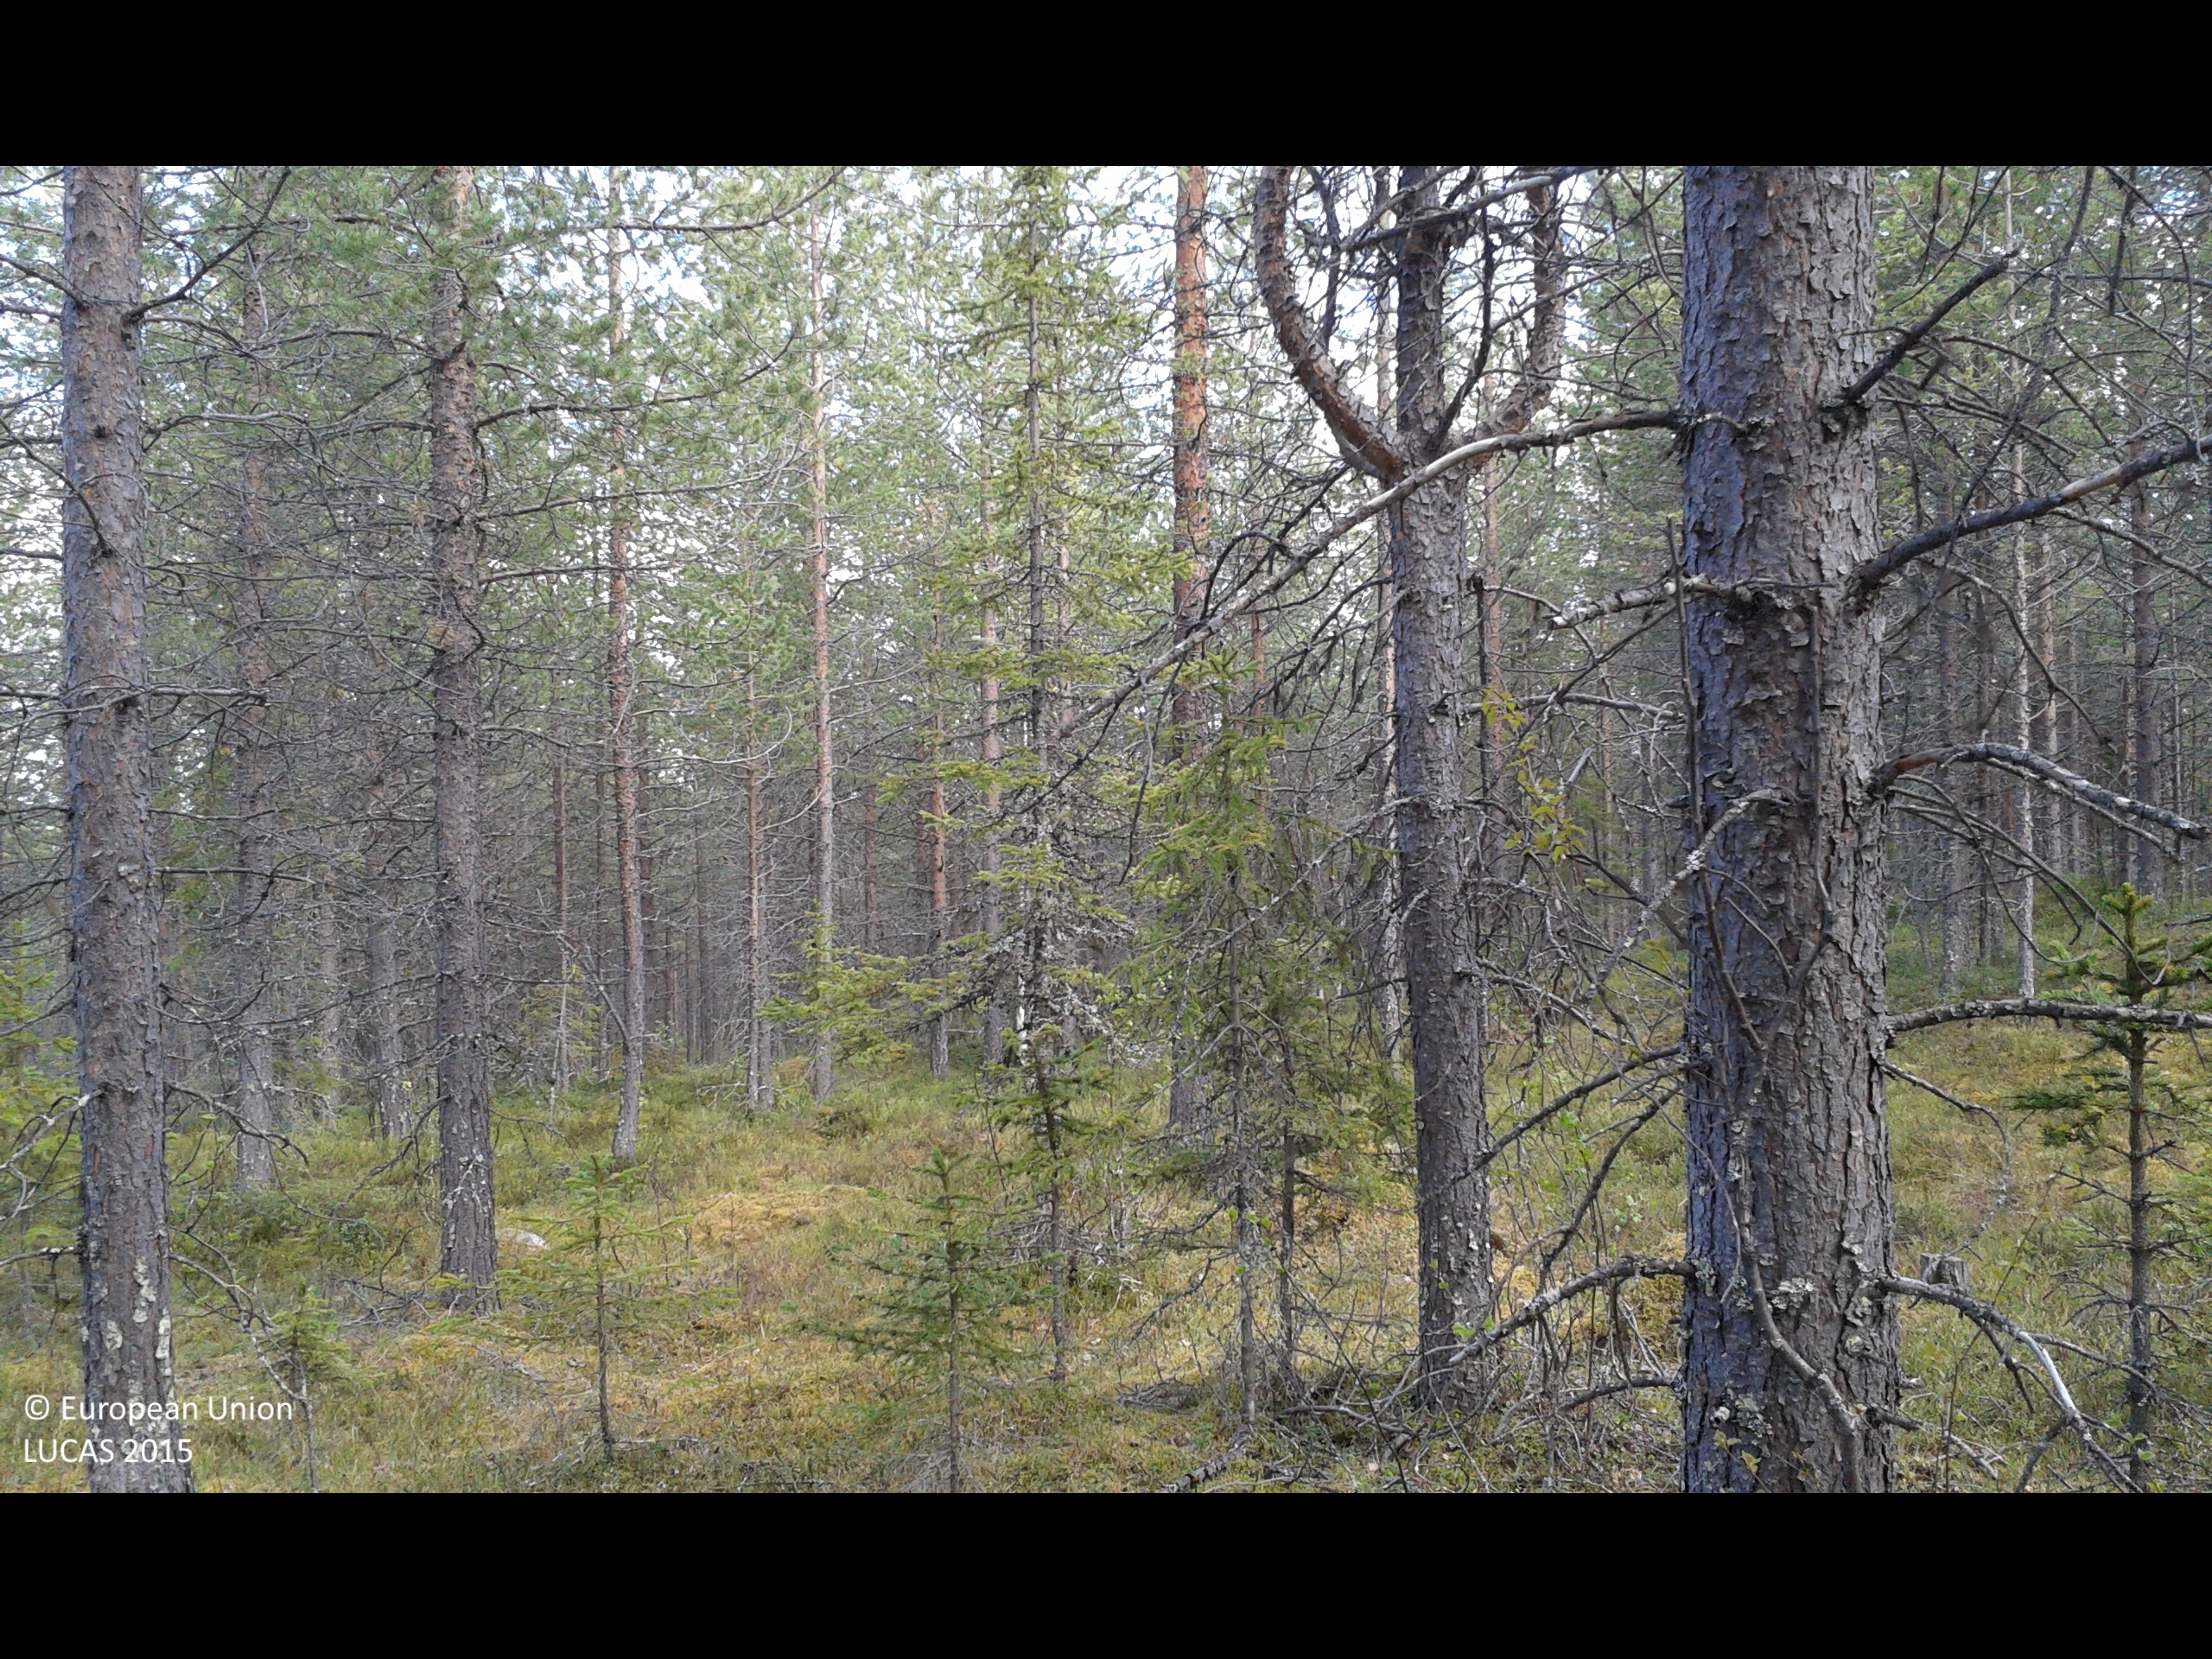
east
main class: Woodland
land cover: Pine dominated coniferous woodland
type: boreal forest
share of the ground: 25 - 50 %
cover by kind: herbaceous plants 55 %, coniferous forest trees 40 %, lichens and mosses 5 %
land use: Forestry
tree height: > 5 m
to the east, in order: Pine dominated coniferous woodland
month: June
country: SE
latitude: 66.9508
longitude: 21.1468
